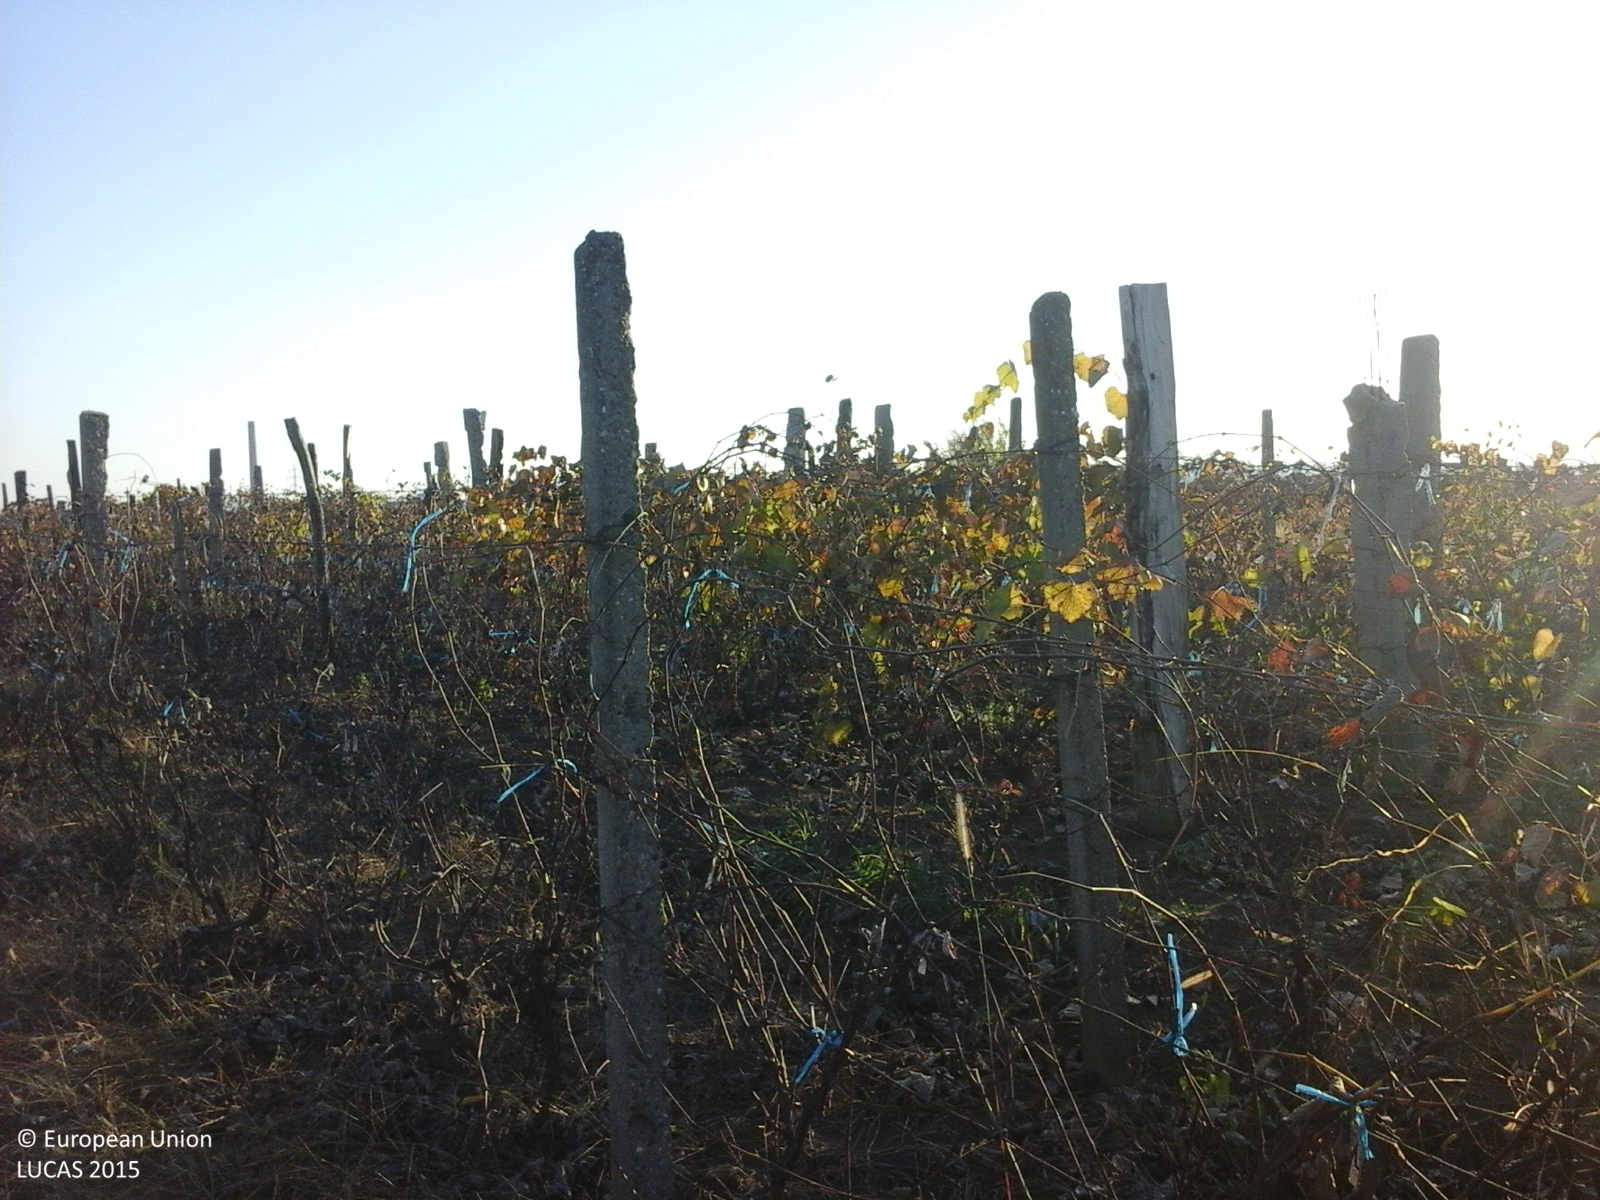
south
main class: Cropland
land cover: Vineyards
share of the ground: 50 - 75 %
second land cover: Other bare soil
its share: > 75 %
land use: Agriculture (excluding fallow land and kitchen gardens)
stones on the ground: < 10 %
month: October
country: RO
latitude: 46.1230
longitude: 27.1938
